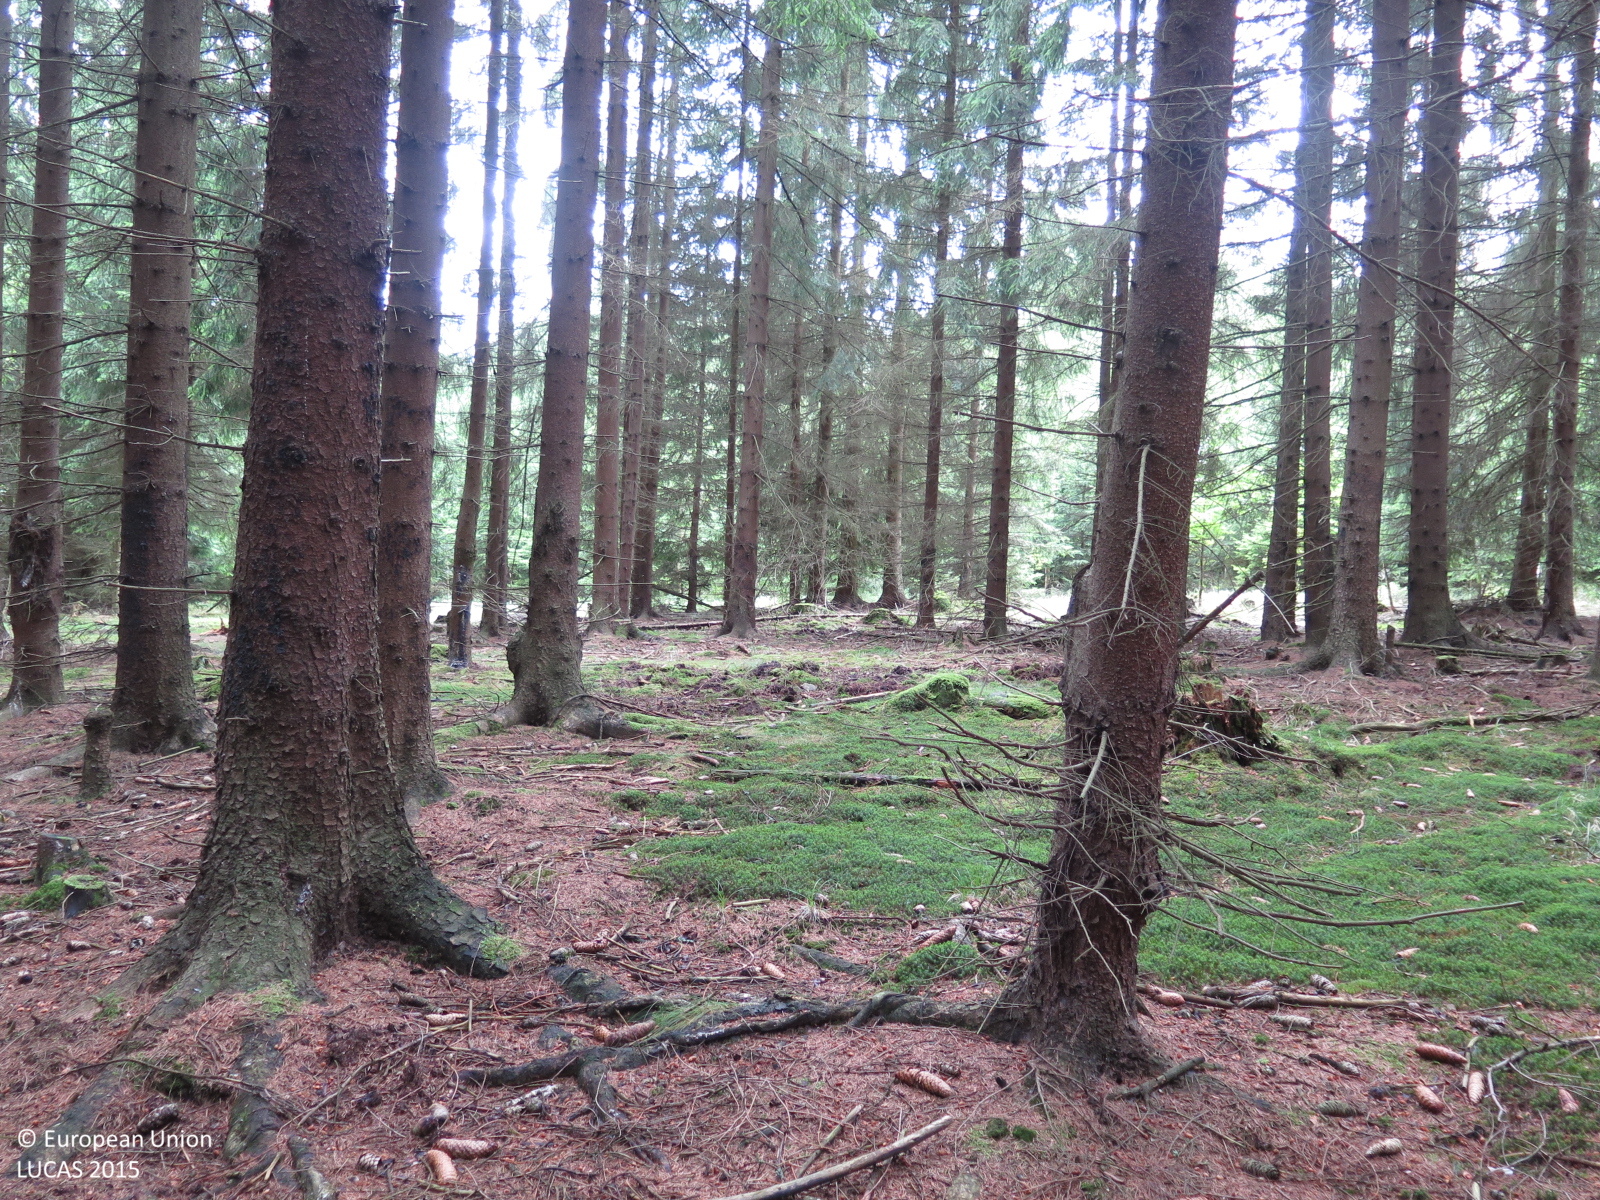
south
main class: Woodland
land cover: Spruce dominated coniferous woodland
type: hemiboreal forest and nemoral coniferous forest and mixed broadleaved-coniferous forest
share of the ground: > 75 %
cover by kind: coniferous forest trees 95 %, lichens and mosses 5 %
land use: Forestry
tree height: > 5 m
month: August
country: CZ
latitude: 49.7603
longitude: 13.8181
